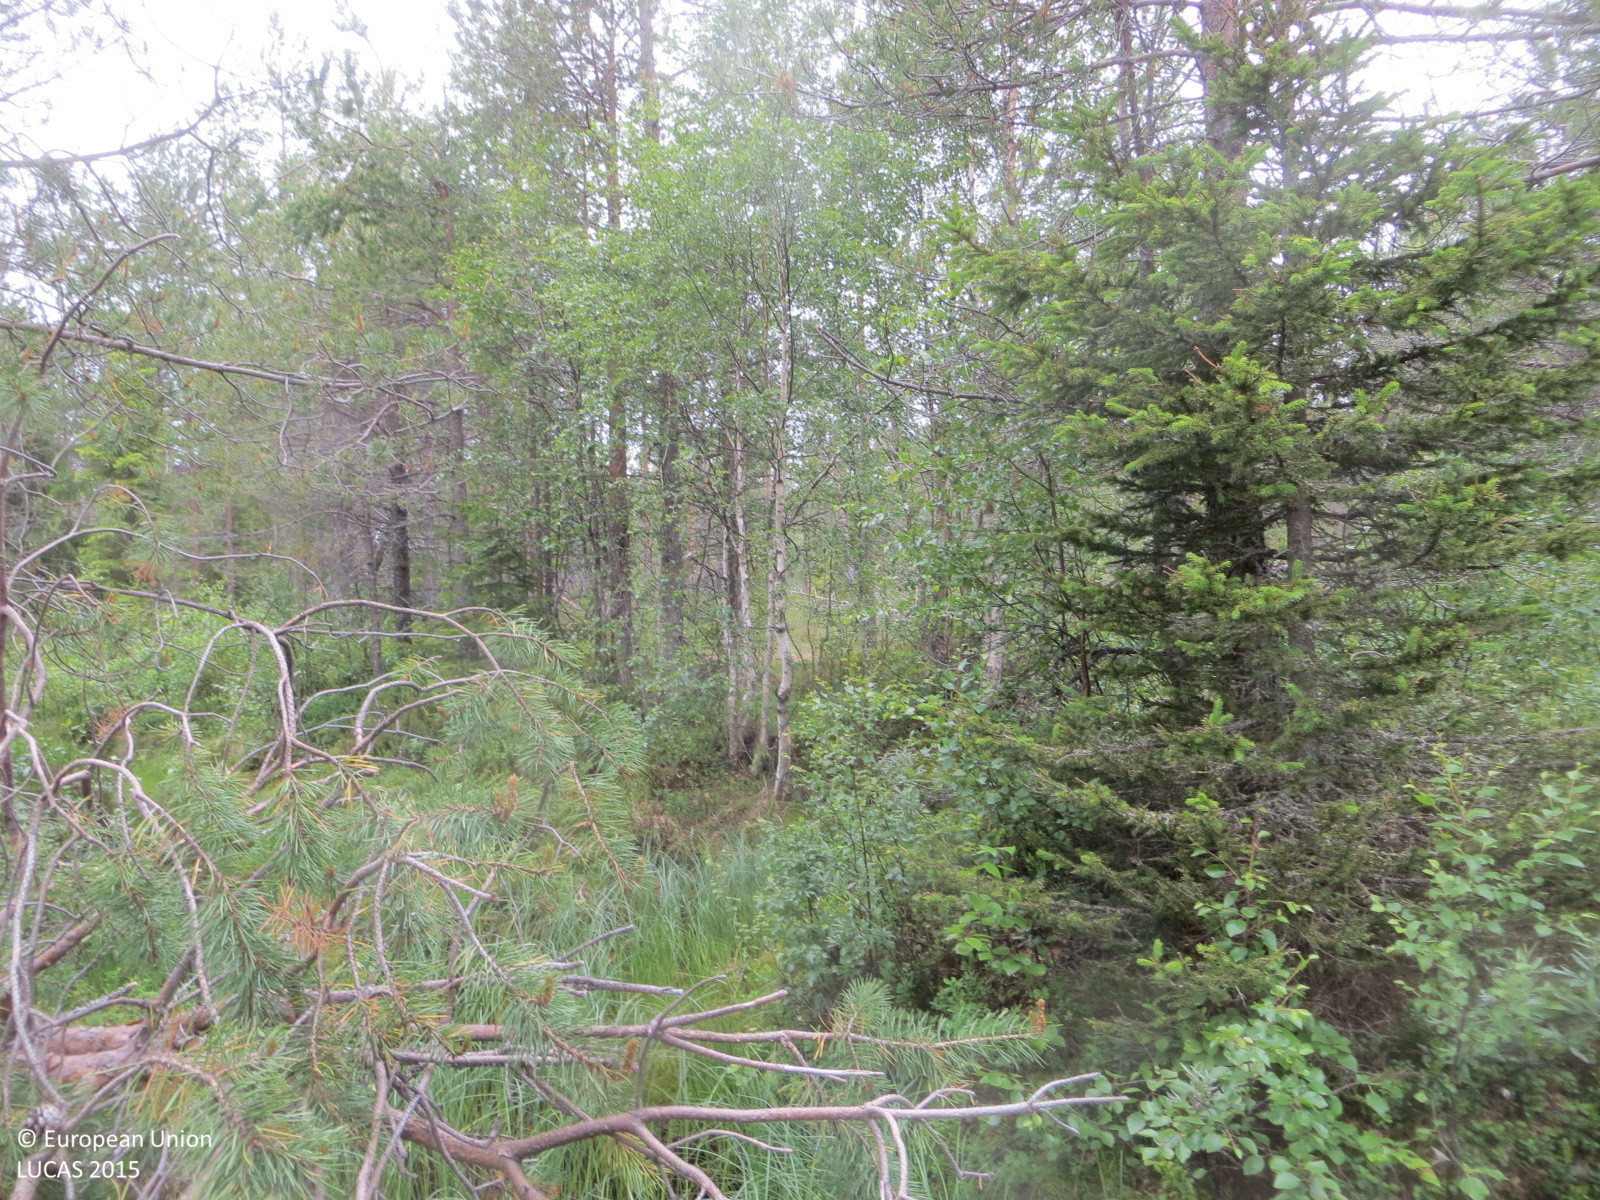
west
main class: Woodland
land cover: Pine dominated coniferous woodland
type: mire and swamp forests
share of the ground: 50 - 75 %
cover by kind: coniferous forest trees 65 %, shrubs 35 %
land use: Forestry
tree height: > 5 m
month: July
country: FI
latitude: 66.3923
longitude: 25.8491
